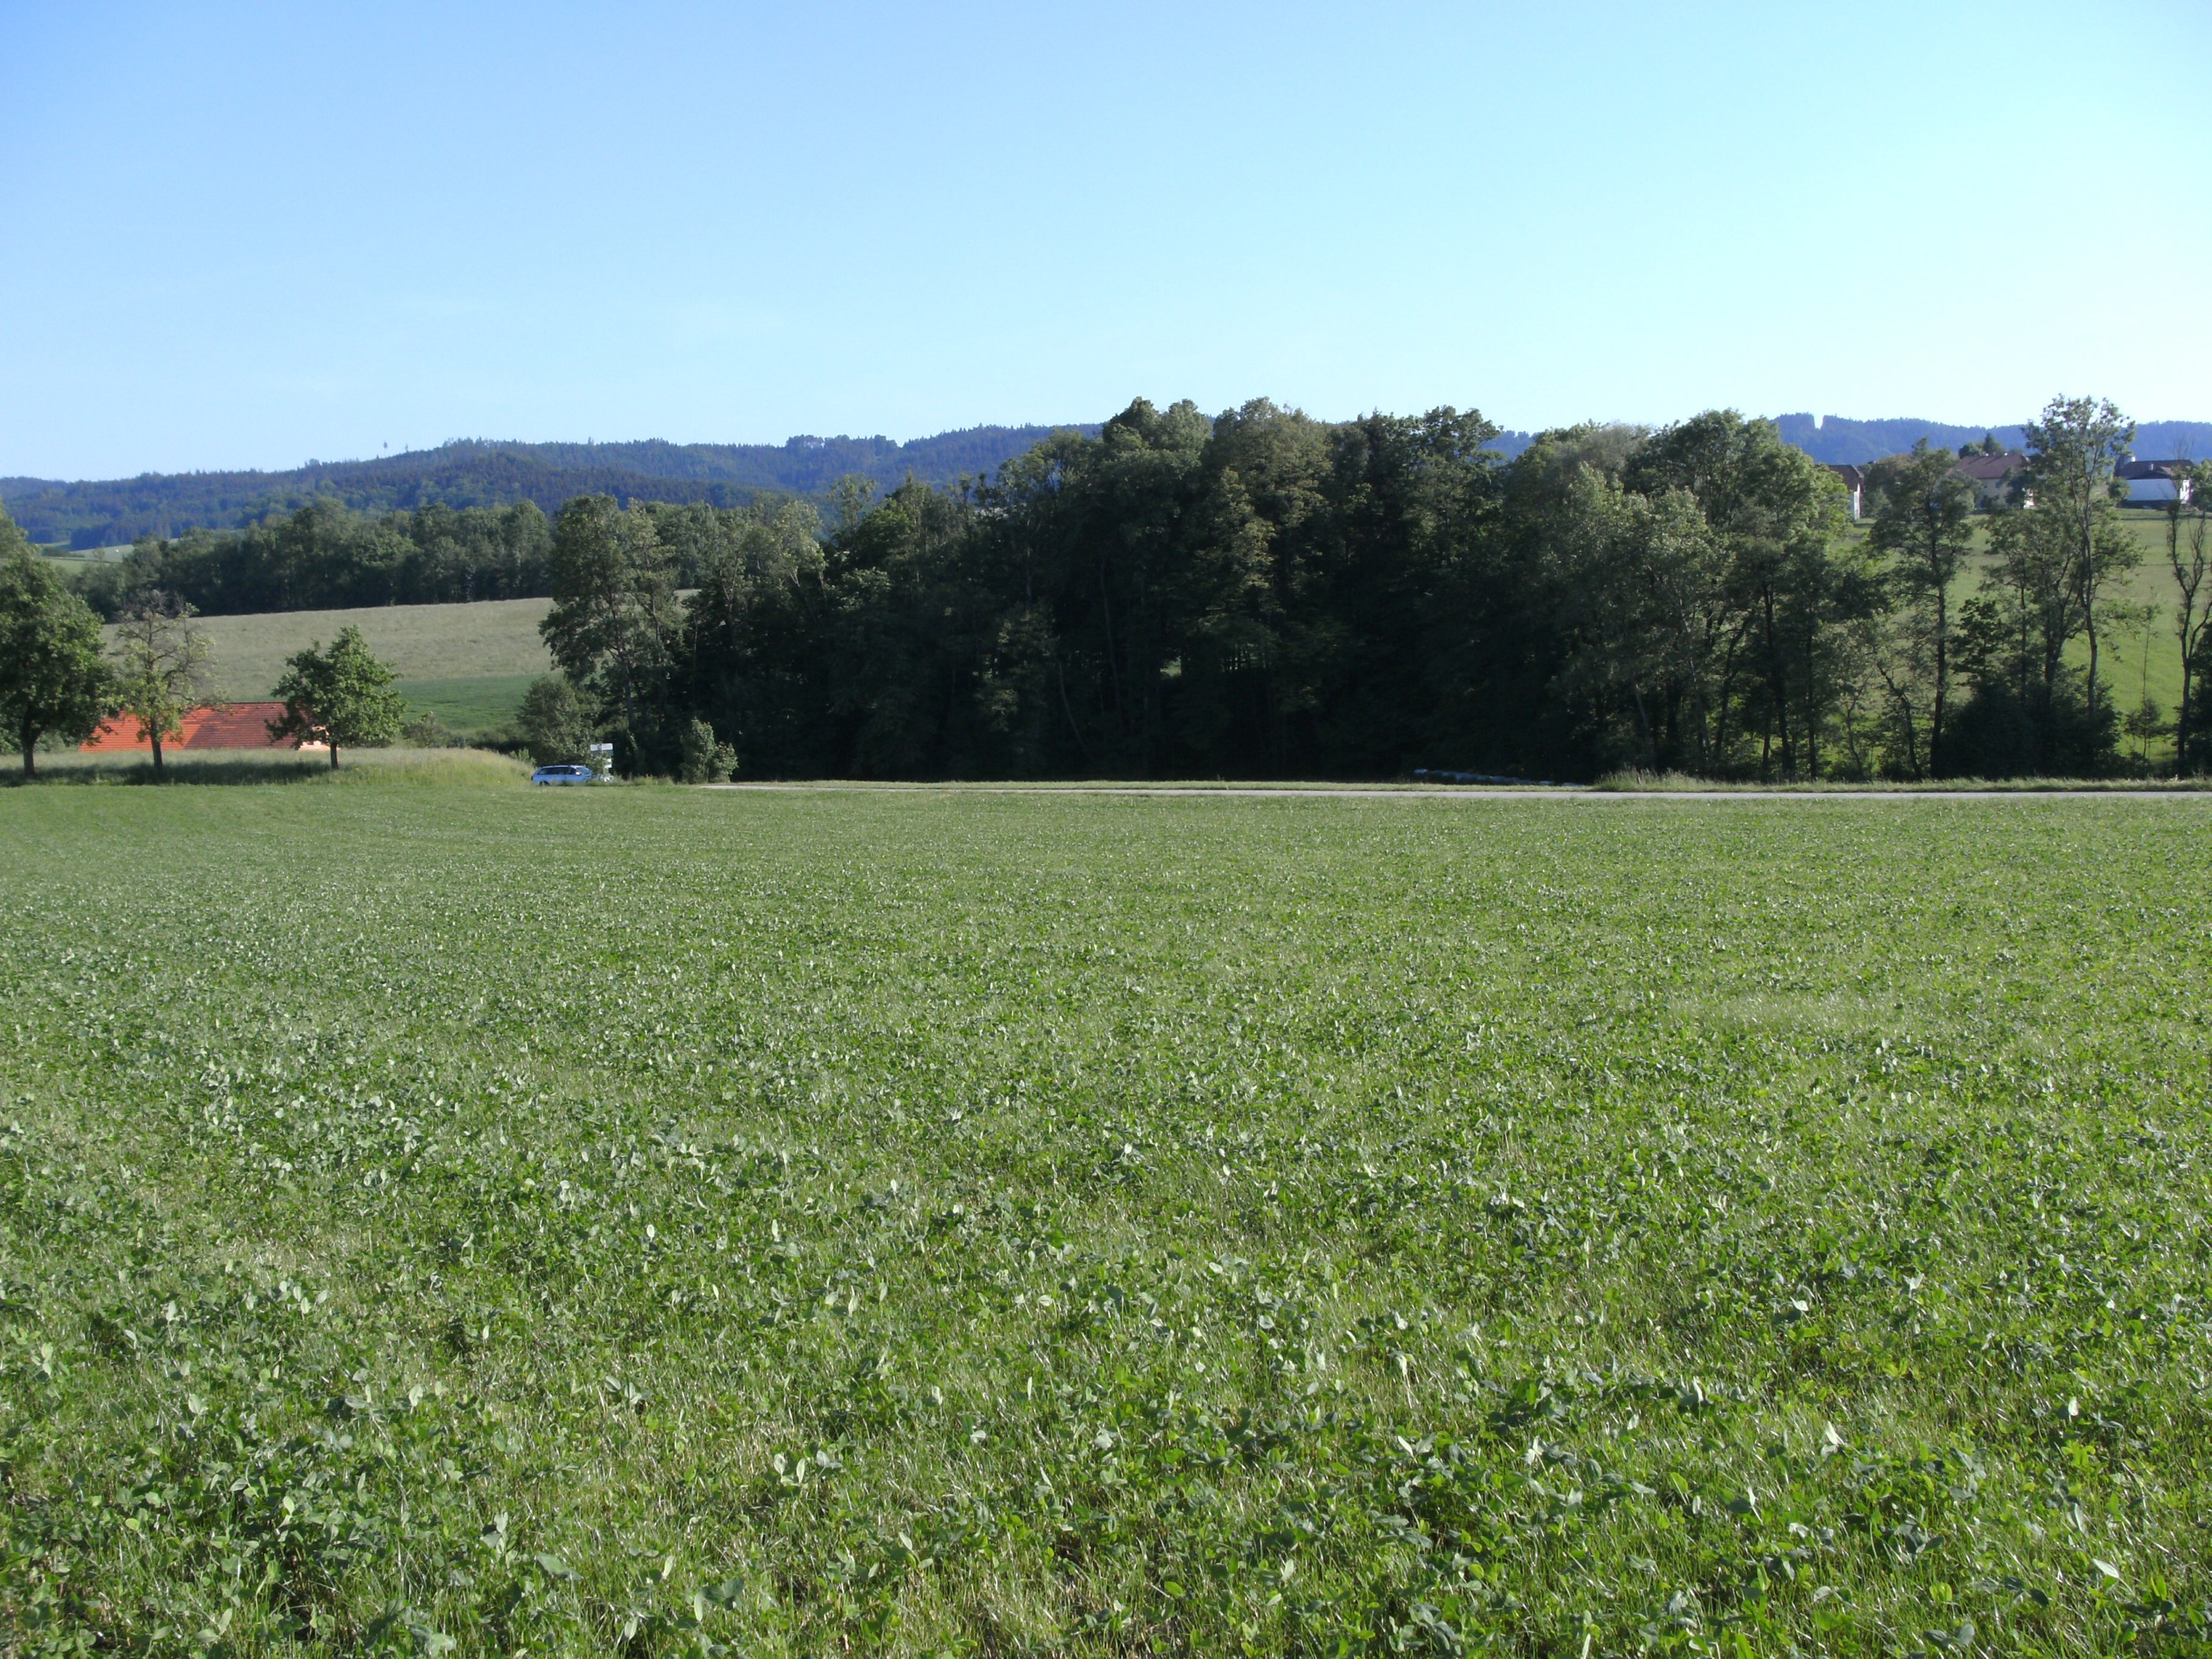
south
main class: Cropland
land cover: Other leguminous and mixtures for fodder
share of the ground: > 75 %
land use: Agriculture (excluding fallow land and kitchen gardens)
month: May
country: AT
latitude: 48.1634
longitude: 13.6429
